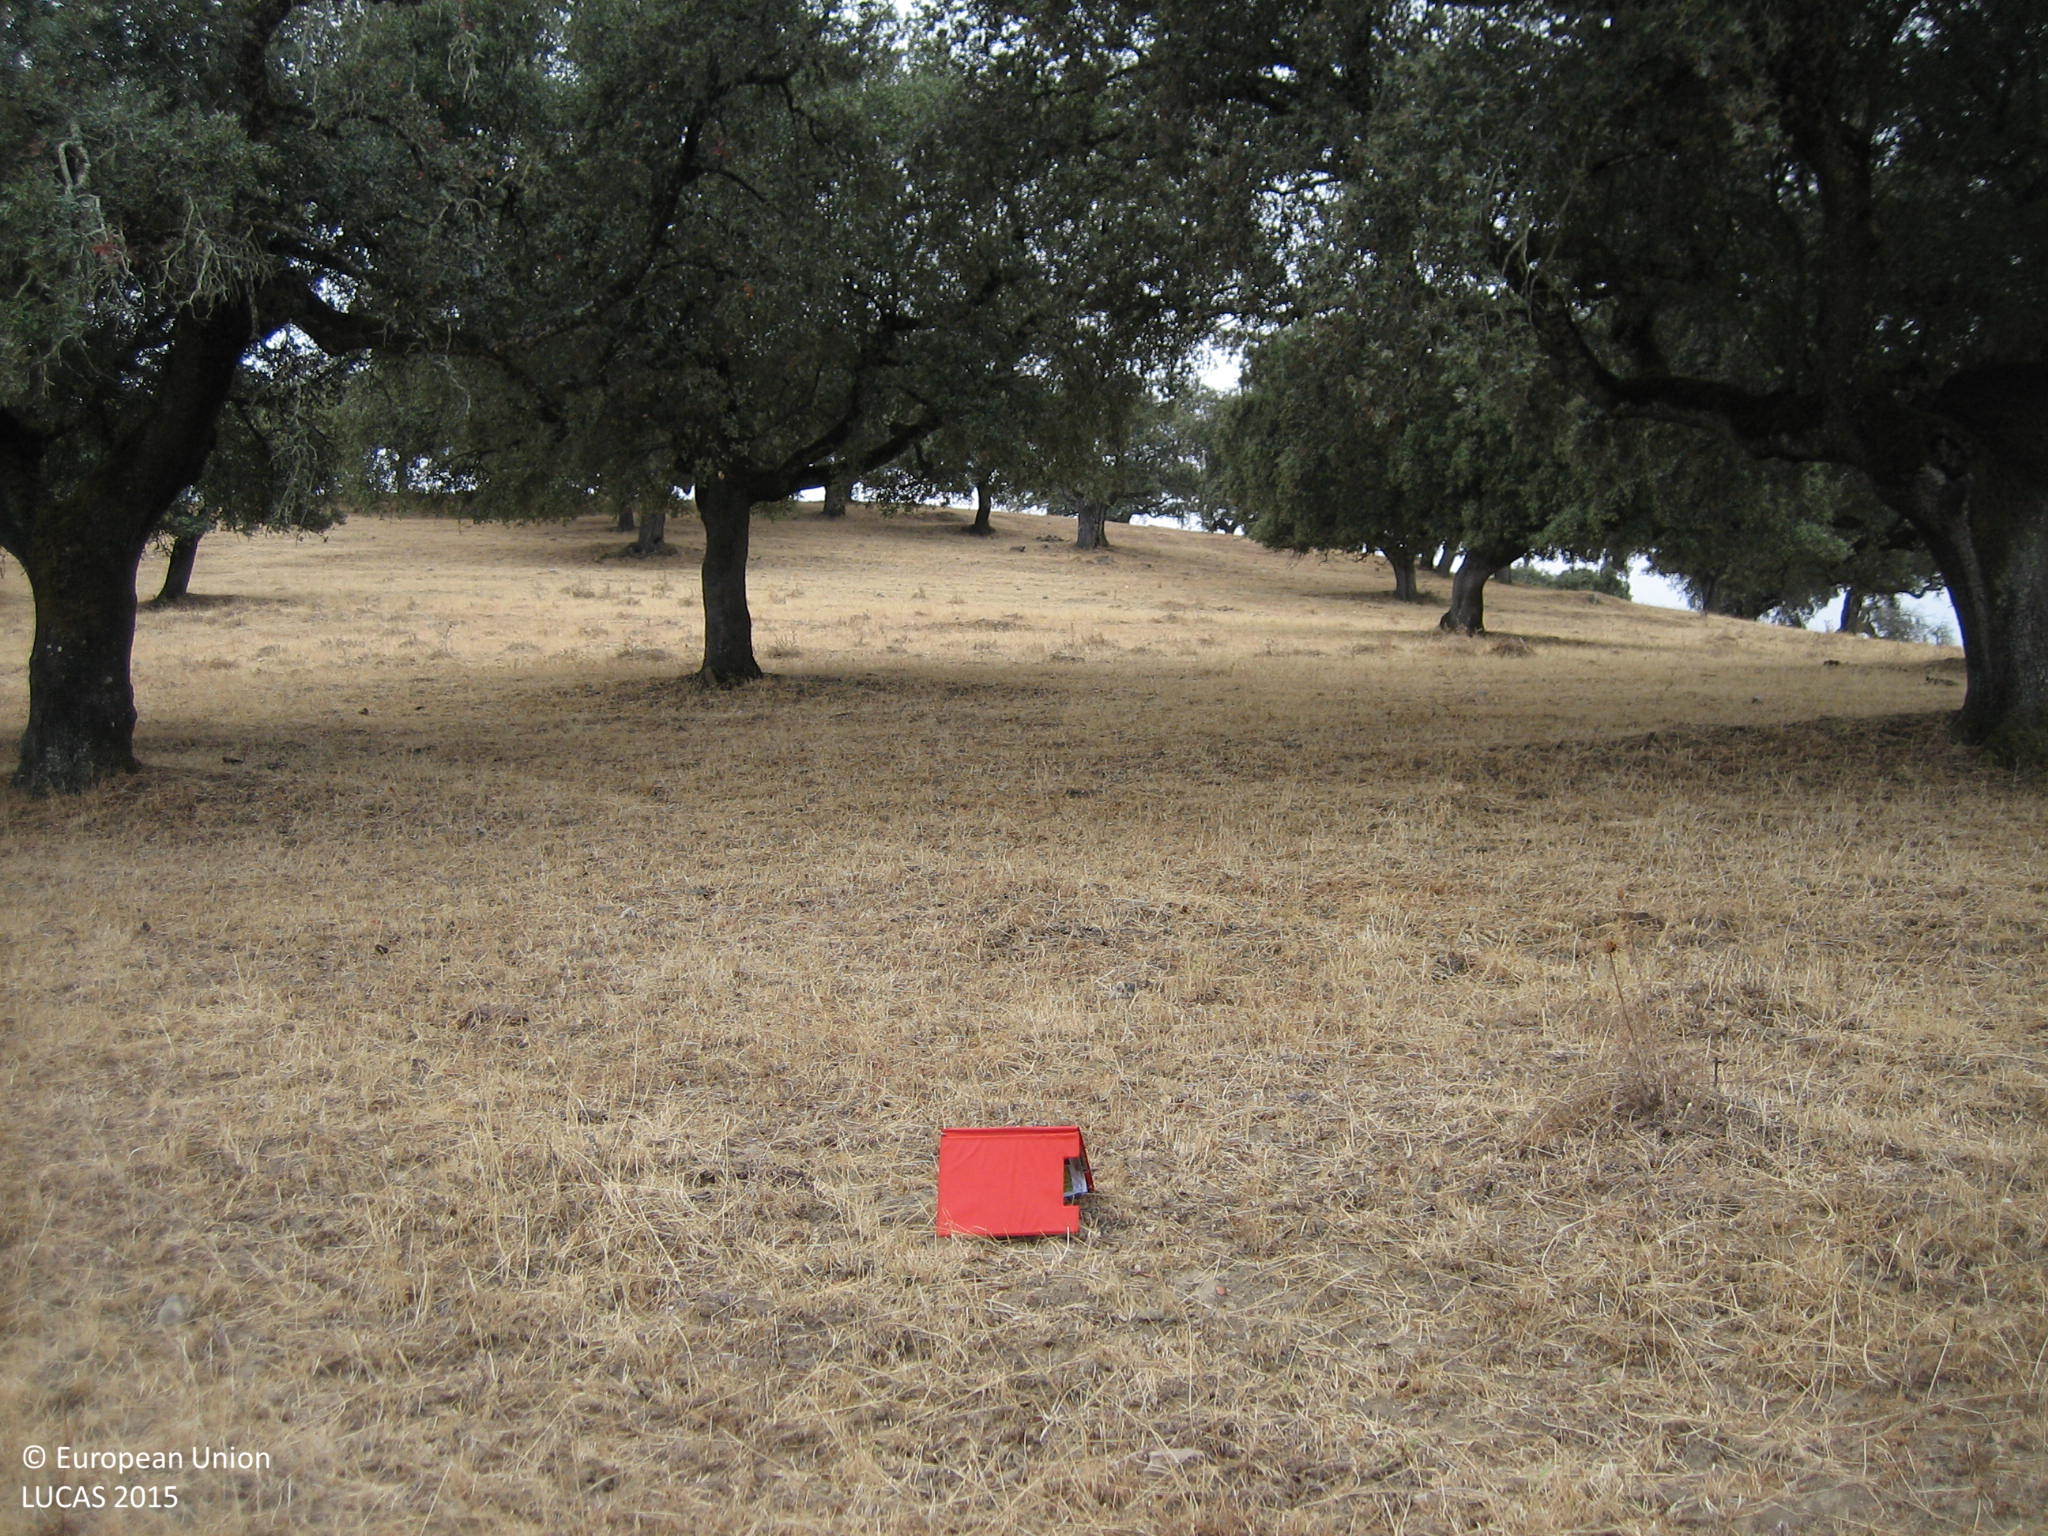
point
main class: Woodland
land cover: Broadleaved woodland
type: broadleaved evergreen forest
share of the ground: 25 - 50 %
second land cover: Grassland without tree/shrub cover
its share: > 75 %
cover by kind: herbaceous plants 60 %, broadleaved forest trees 40 %
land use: Forestry
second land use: Agriculture (excluding fallow land and kitchen gardens)
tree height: > 5 m
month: September
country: ES
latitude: 38.3033
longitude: -6.8319
